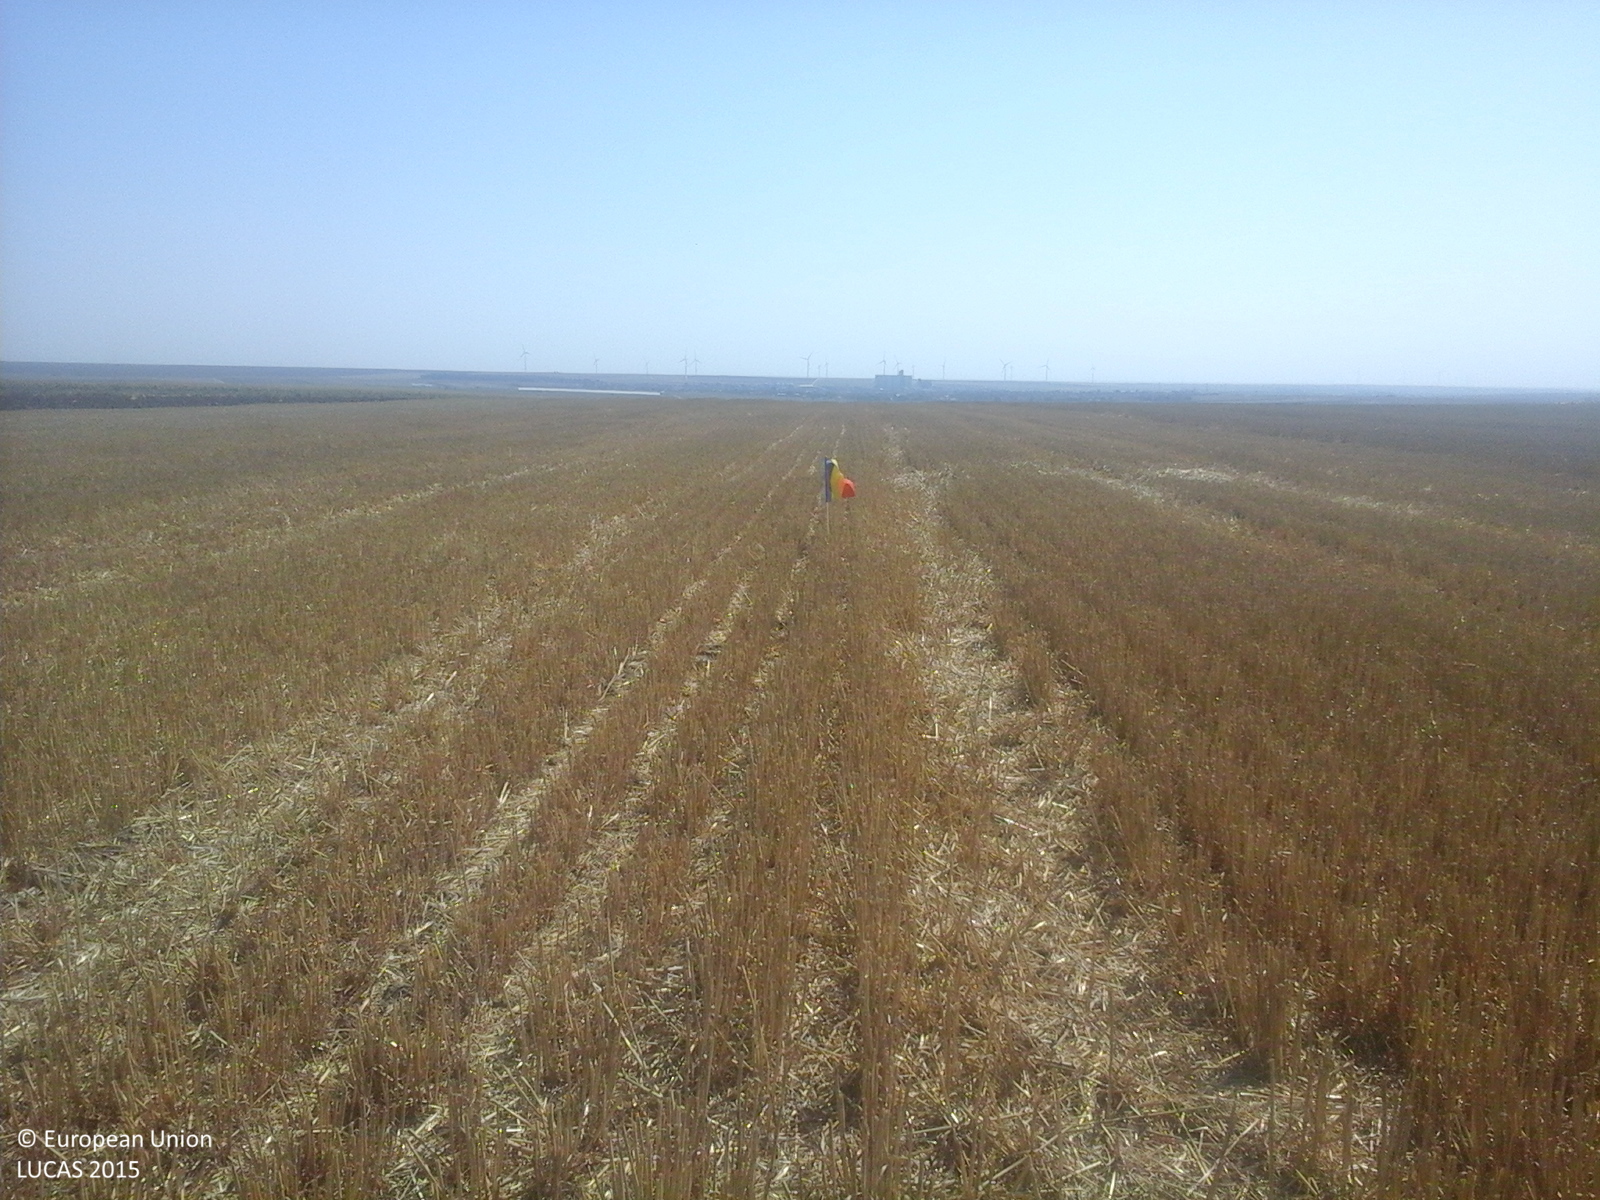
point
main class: Cropland
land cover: Common wheat
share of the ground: > 75 %
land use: Agriculture (excluding fallow land and kitchen gardens)
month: August
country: RO
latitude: 44.4240
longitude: 28.3950
